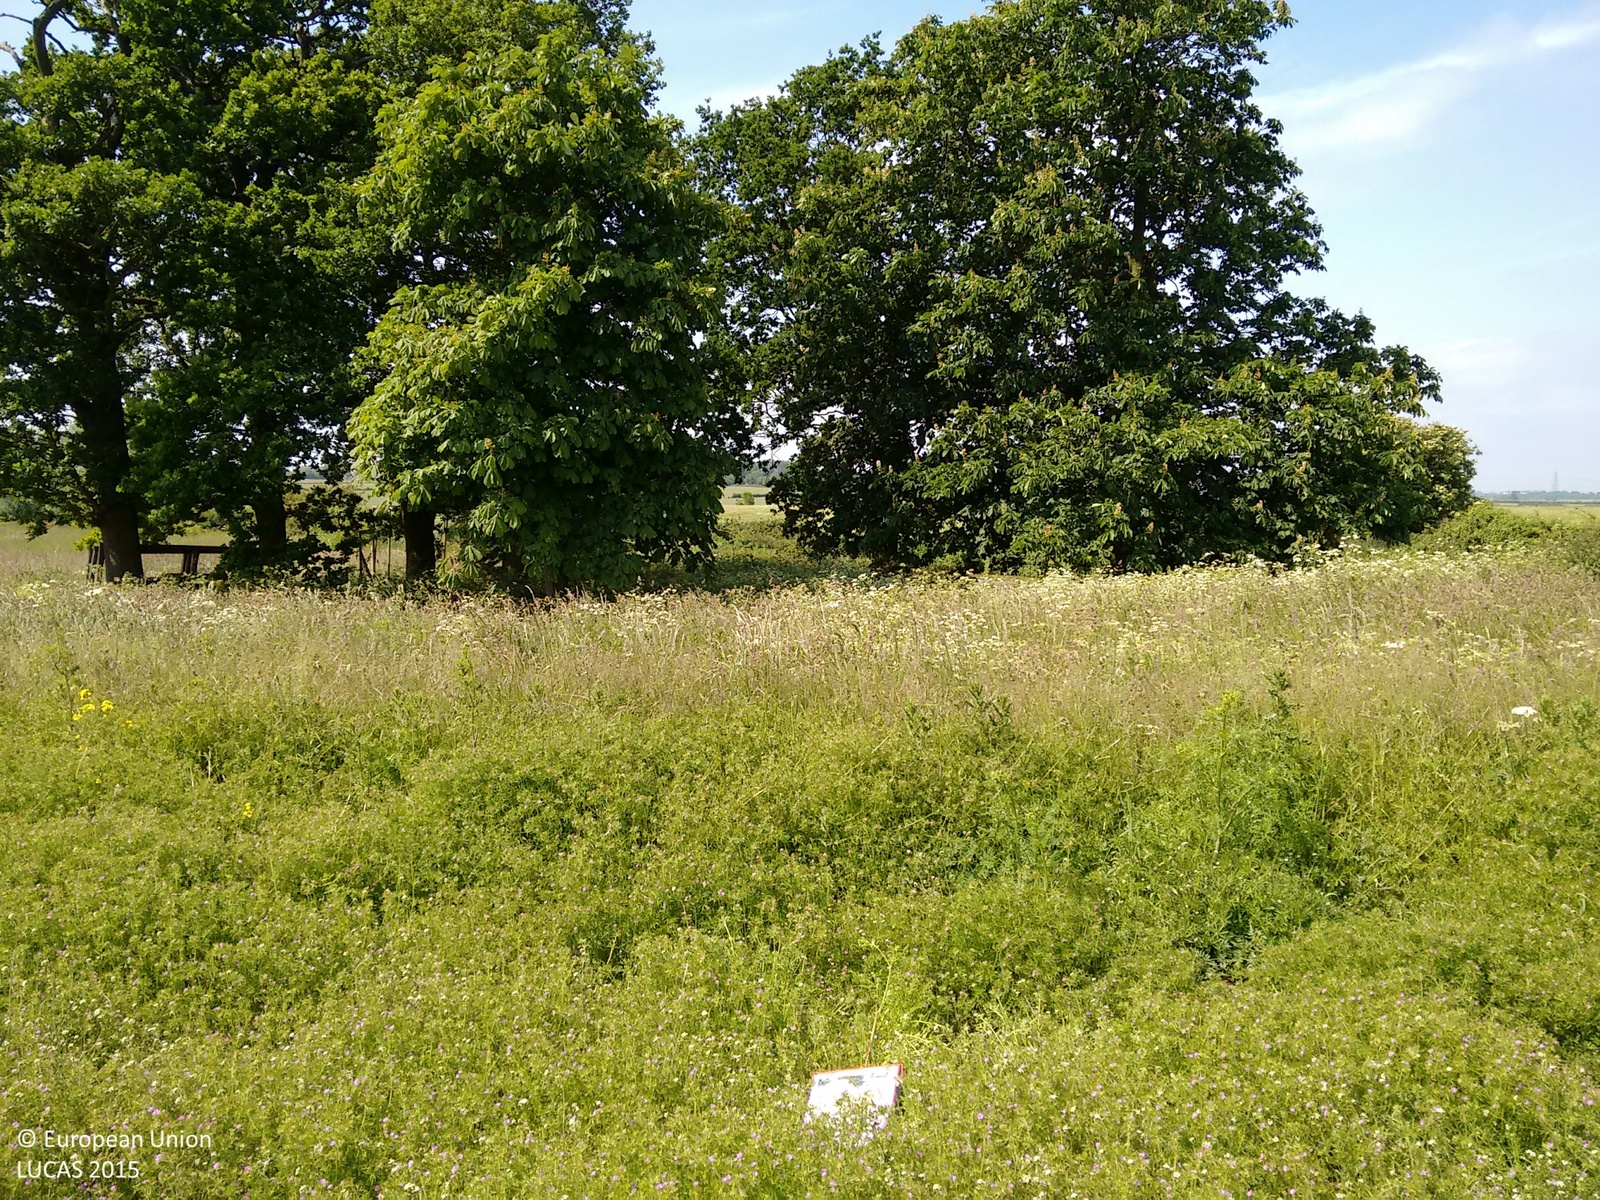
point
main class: Grassland
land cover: Spontaneously vegetated surfaces
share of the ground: > 75 %
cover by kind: herbaceous plants 100 %
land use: Agriculture (excluding fallow land and kitchen gardens)
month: June
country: GB
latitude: 52.9614
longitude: -0.7145
